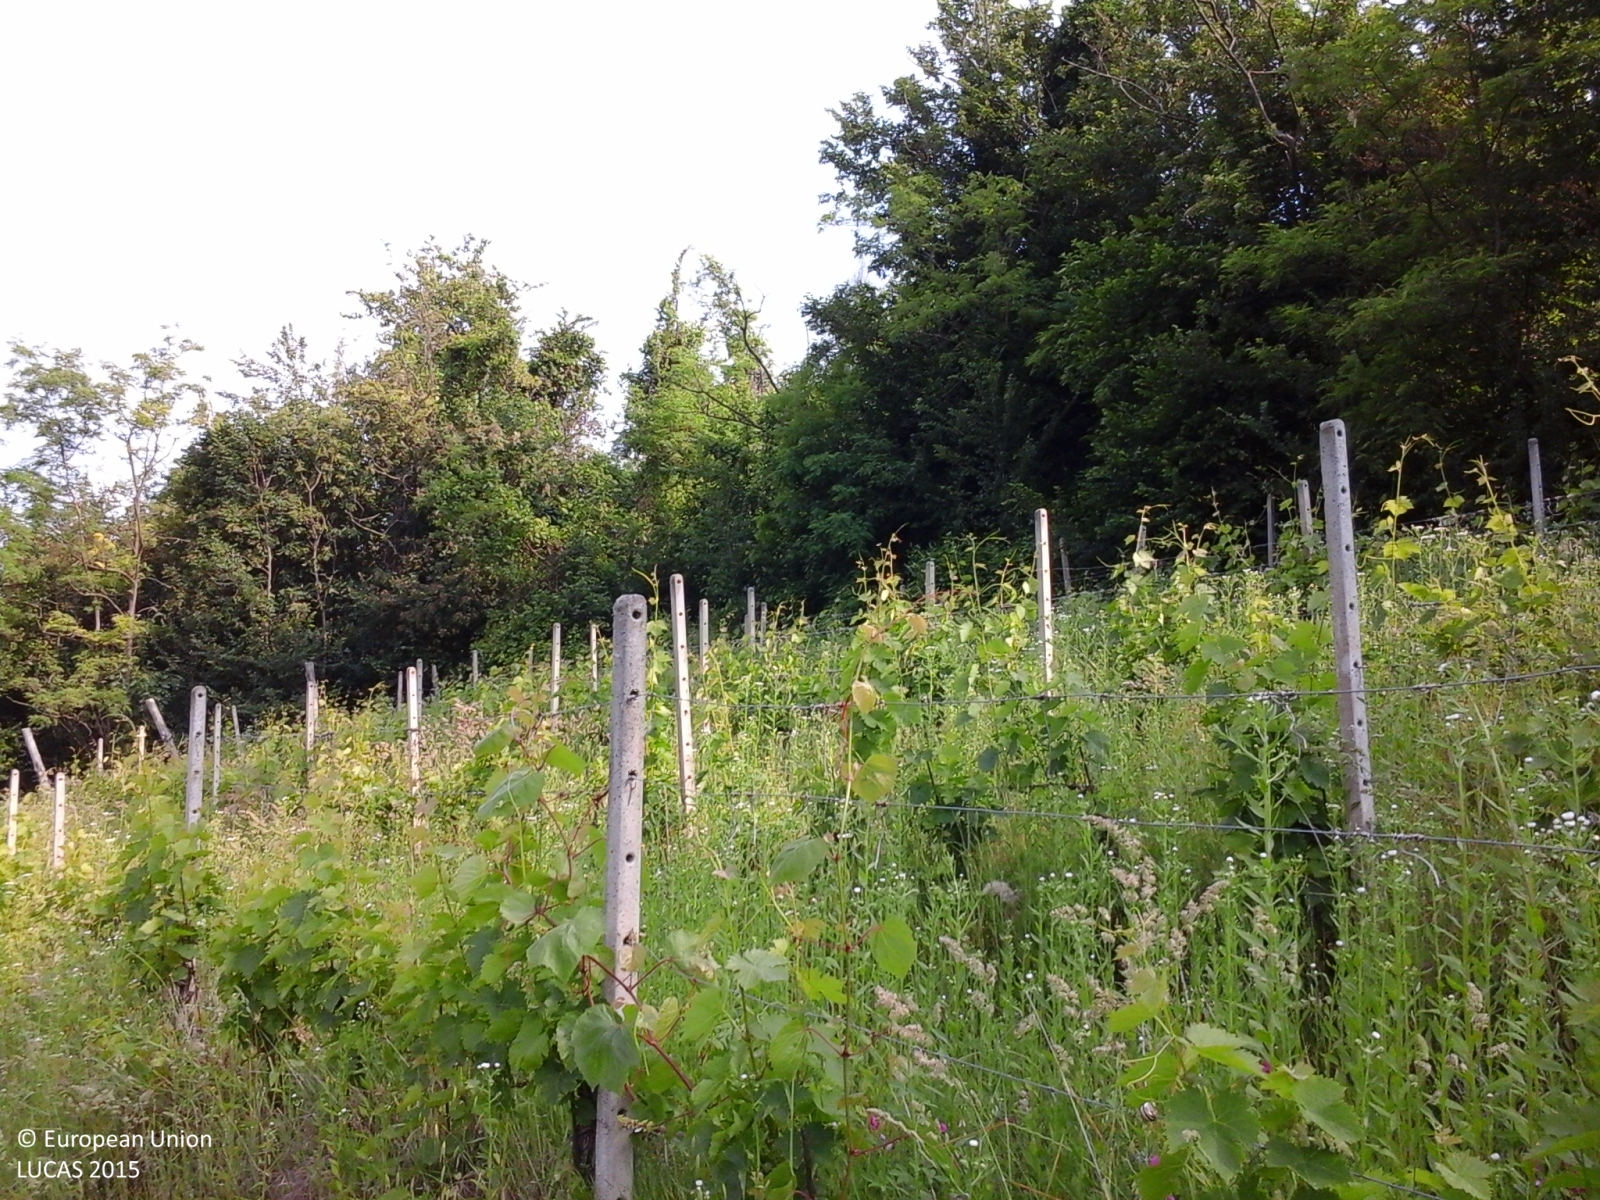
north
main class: Cropland
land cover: Vineyards
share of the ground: 25 - 50 %
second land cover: Grassland without tree/shrub cover
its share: > 75 %
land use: Agriculture (excluding fallow land and kitchen gardens)
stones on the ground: < 10 %
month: May
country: IT
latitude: 44.6982
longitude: 8.3502
